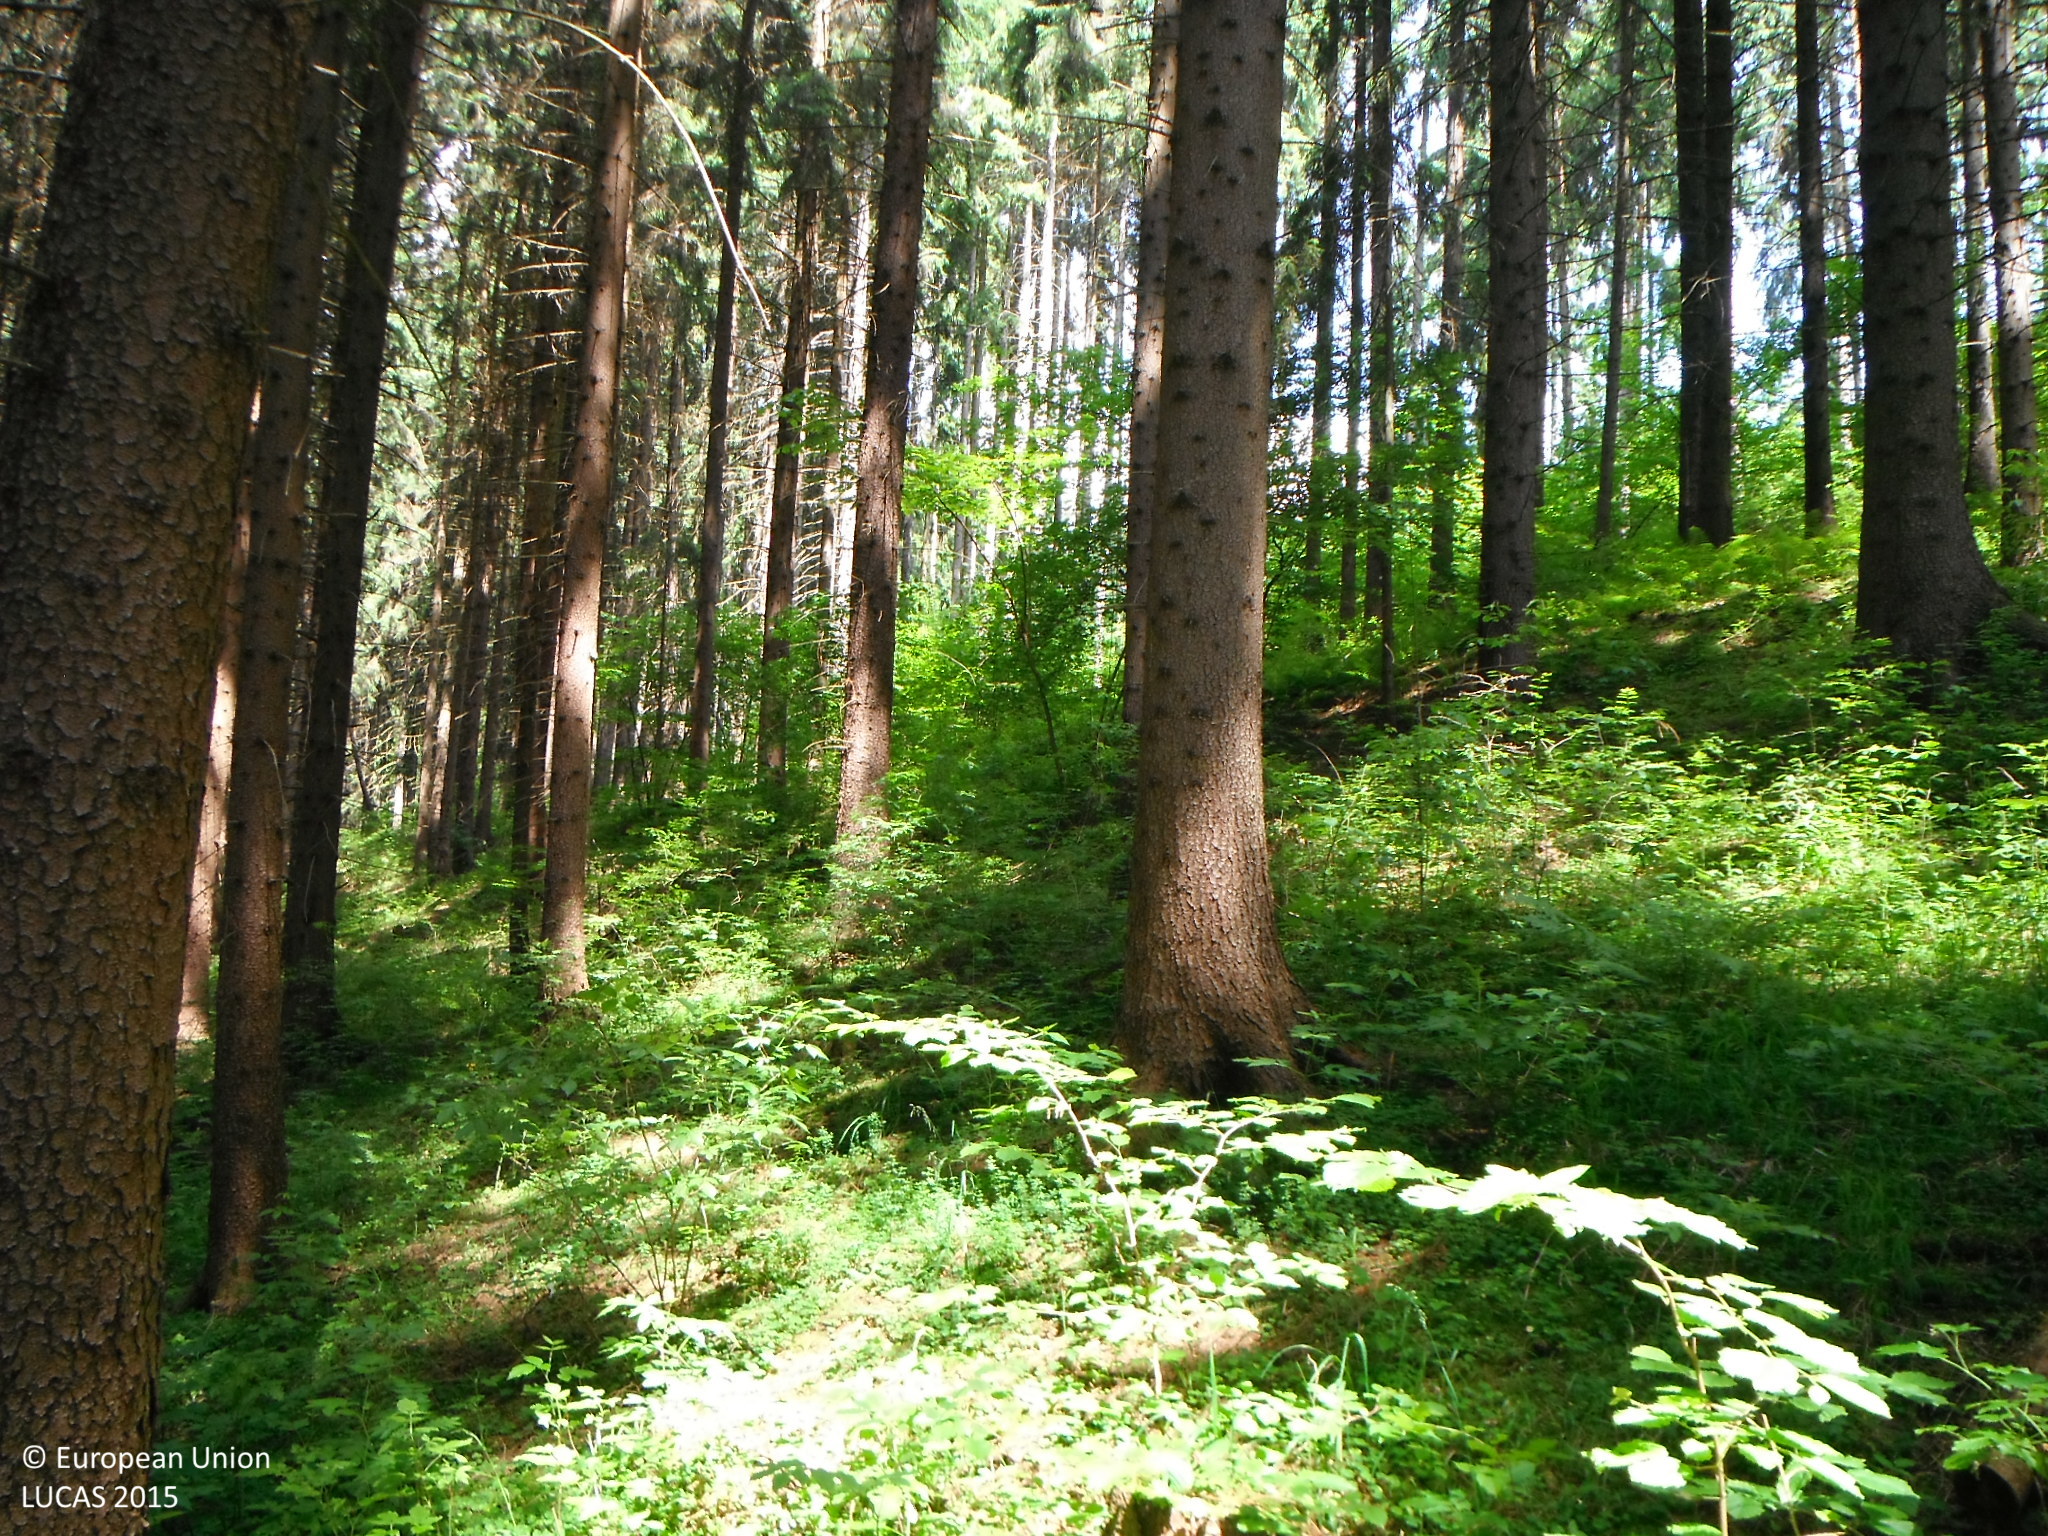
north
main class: Woodland
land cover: Spruce dominated coniferous woodland
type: alpine coniferous forest
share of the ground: > 75 %
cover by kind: coniferous forest trees 90 %, herbaceous plants 10 %
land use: Forestry
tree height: > 5 m
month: June
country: SK
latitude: 49.1890
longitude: 19.2860
